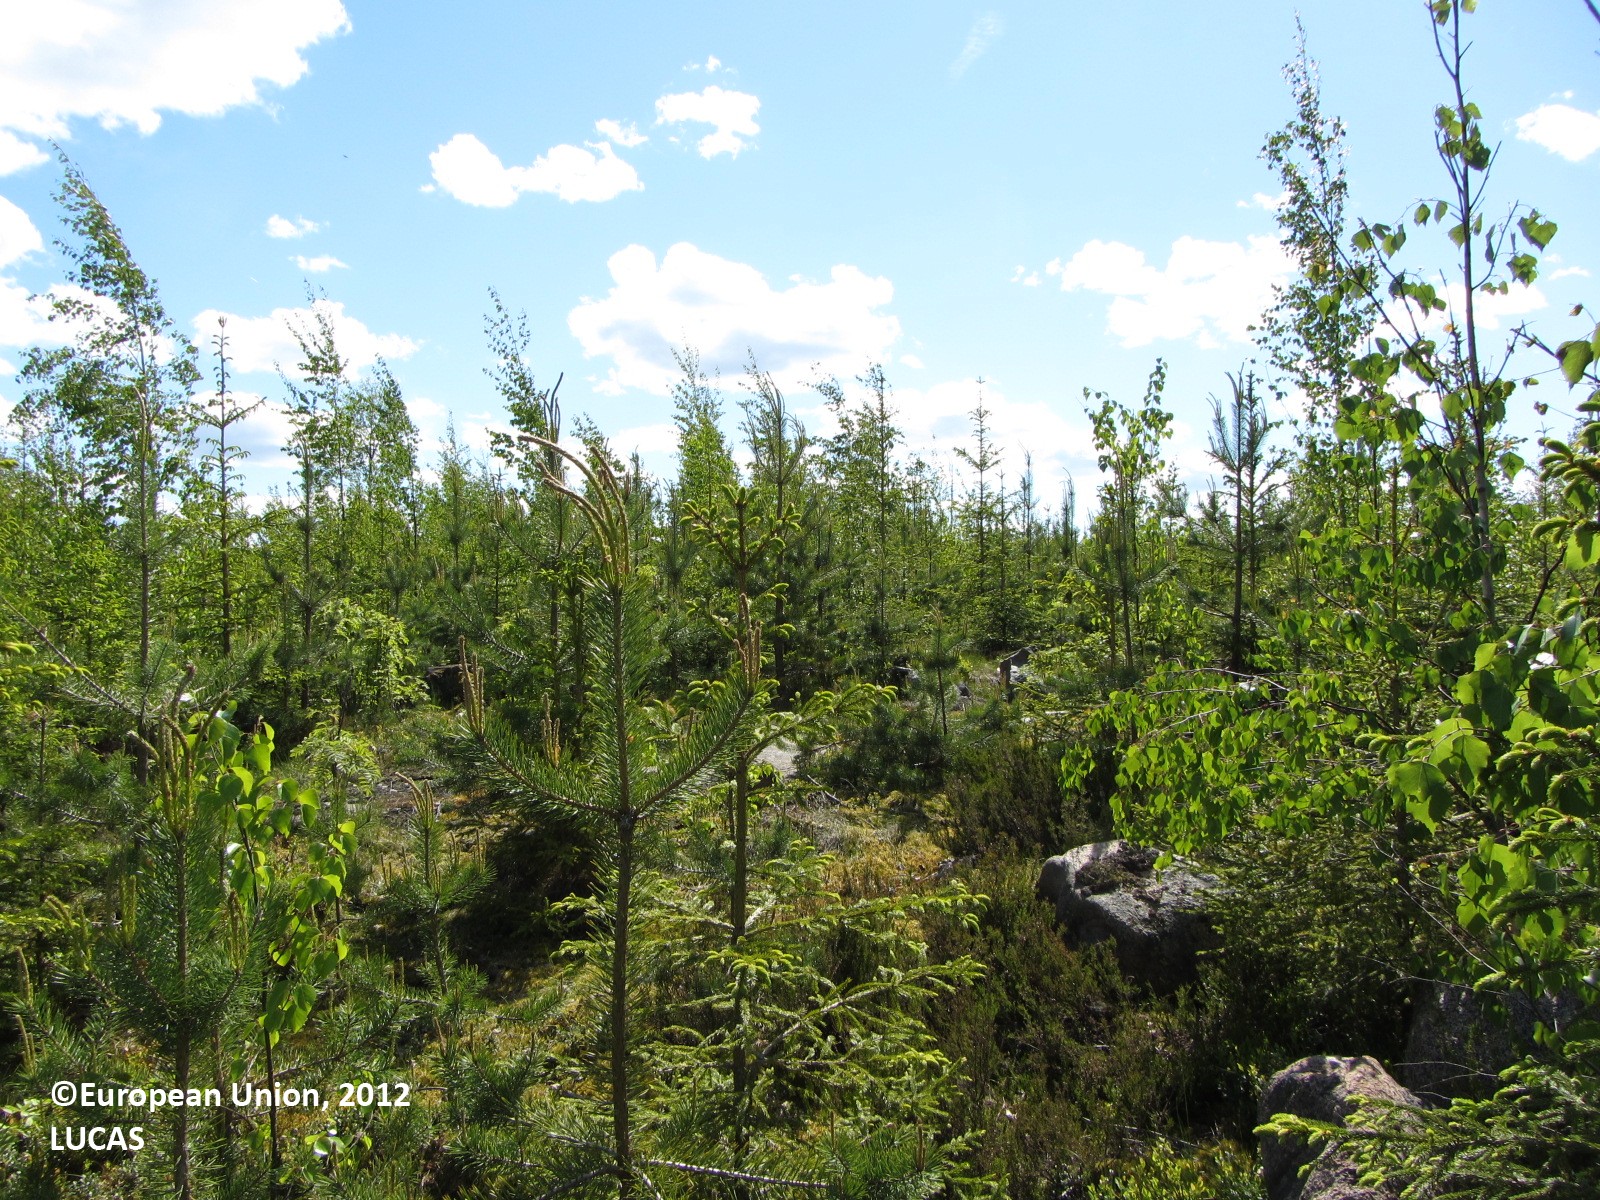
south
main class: Woodland
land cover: Other mixed woodland
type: hemiboreal forest and nemoral coniferous forest and mixed broadleaved-coniferous forest
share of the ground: > 75 %
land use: Forestry
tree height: < 5 m
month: June
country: FI
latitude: 61.7318
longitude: 25.1197
